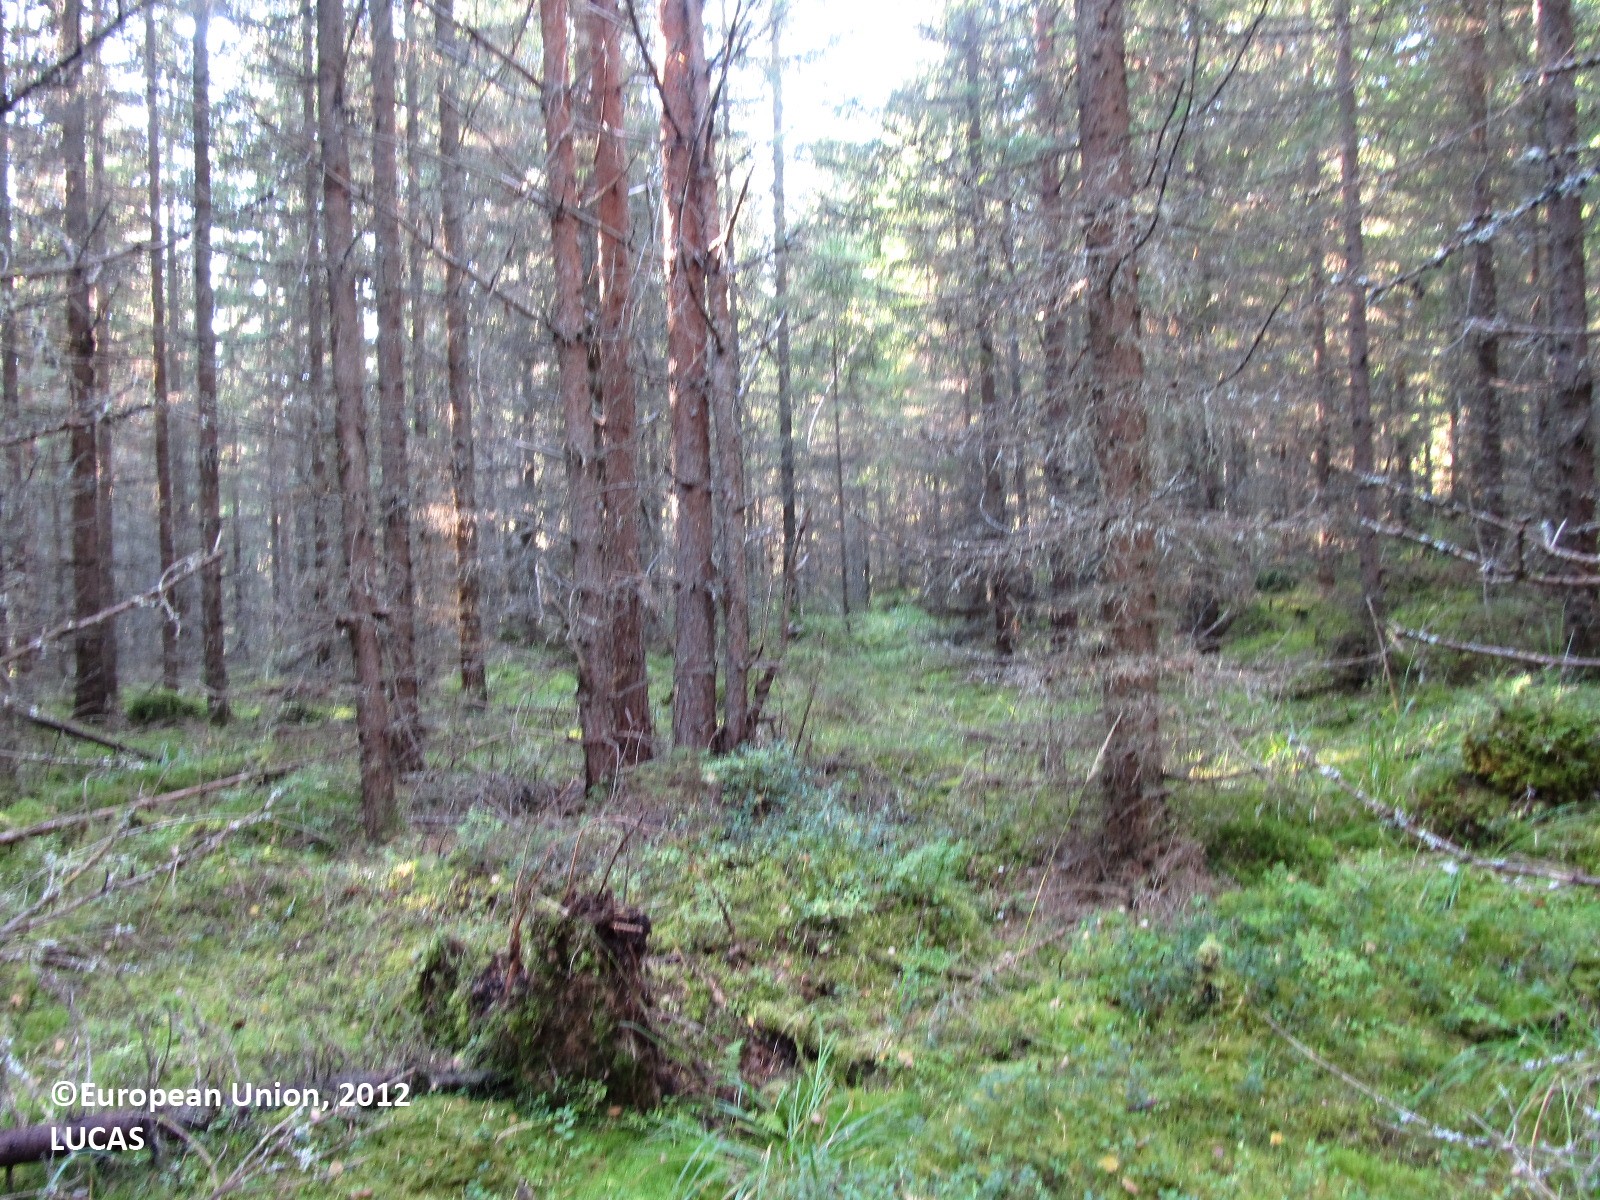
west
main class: Woodland
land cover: Pine dominated coniferous woodland
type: boreal forest
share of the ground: 50 - 75 %
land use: Forestry
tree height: > 5 m
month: September
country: FI
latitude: 62.3973
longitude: 28.3635
